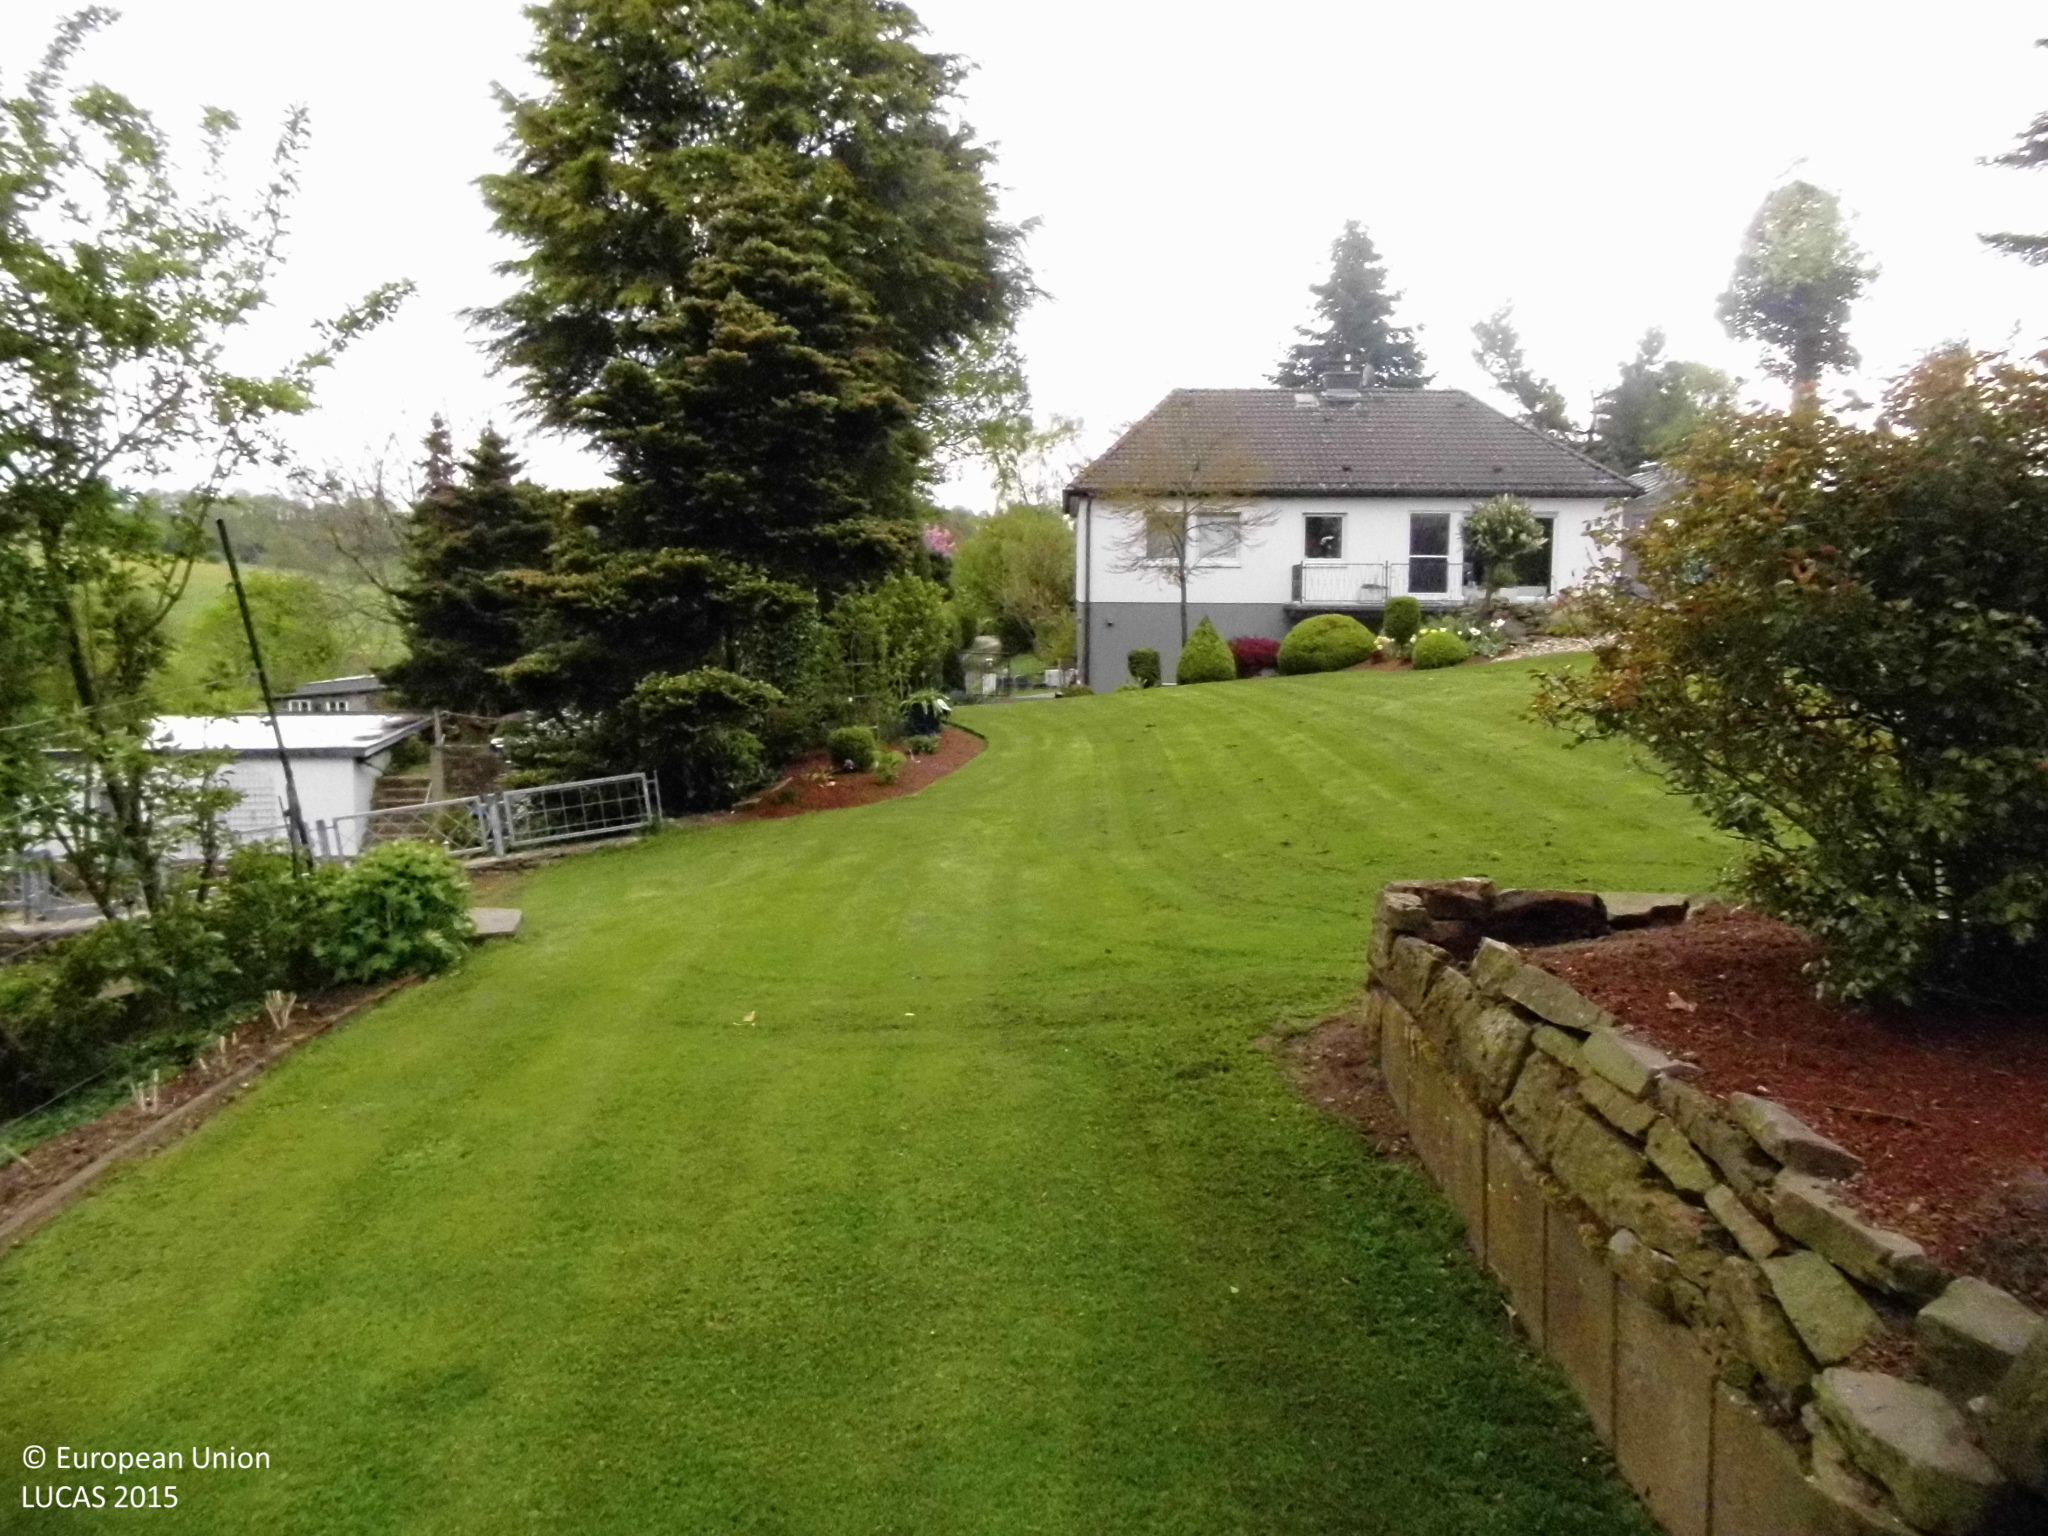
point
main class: Grassland
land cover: Grassland without tree/shrub cover
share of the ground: > 75 %
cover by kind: herbaceous plants 100 %
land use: Residential
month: May
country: DE
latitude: 51.2707
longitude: 7.4345
